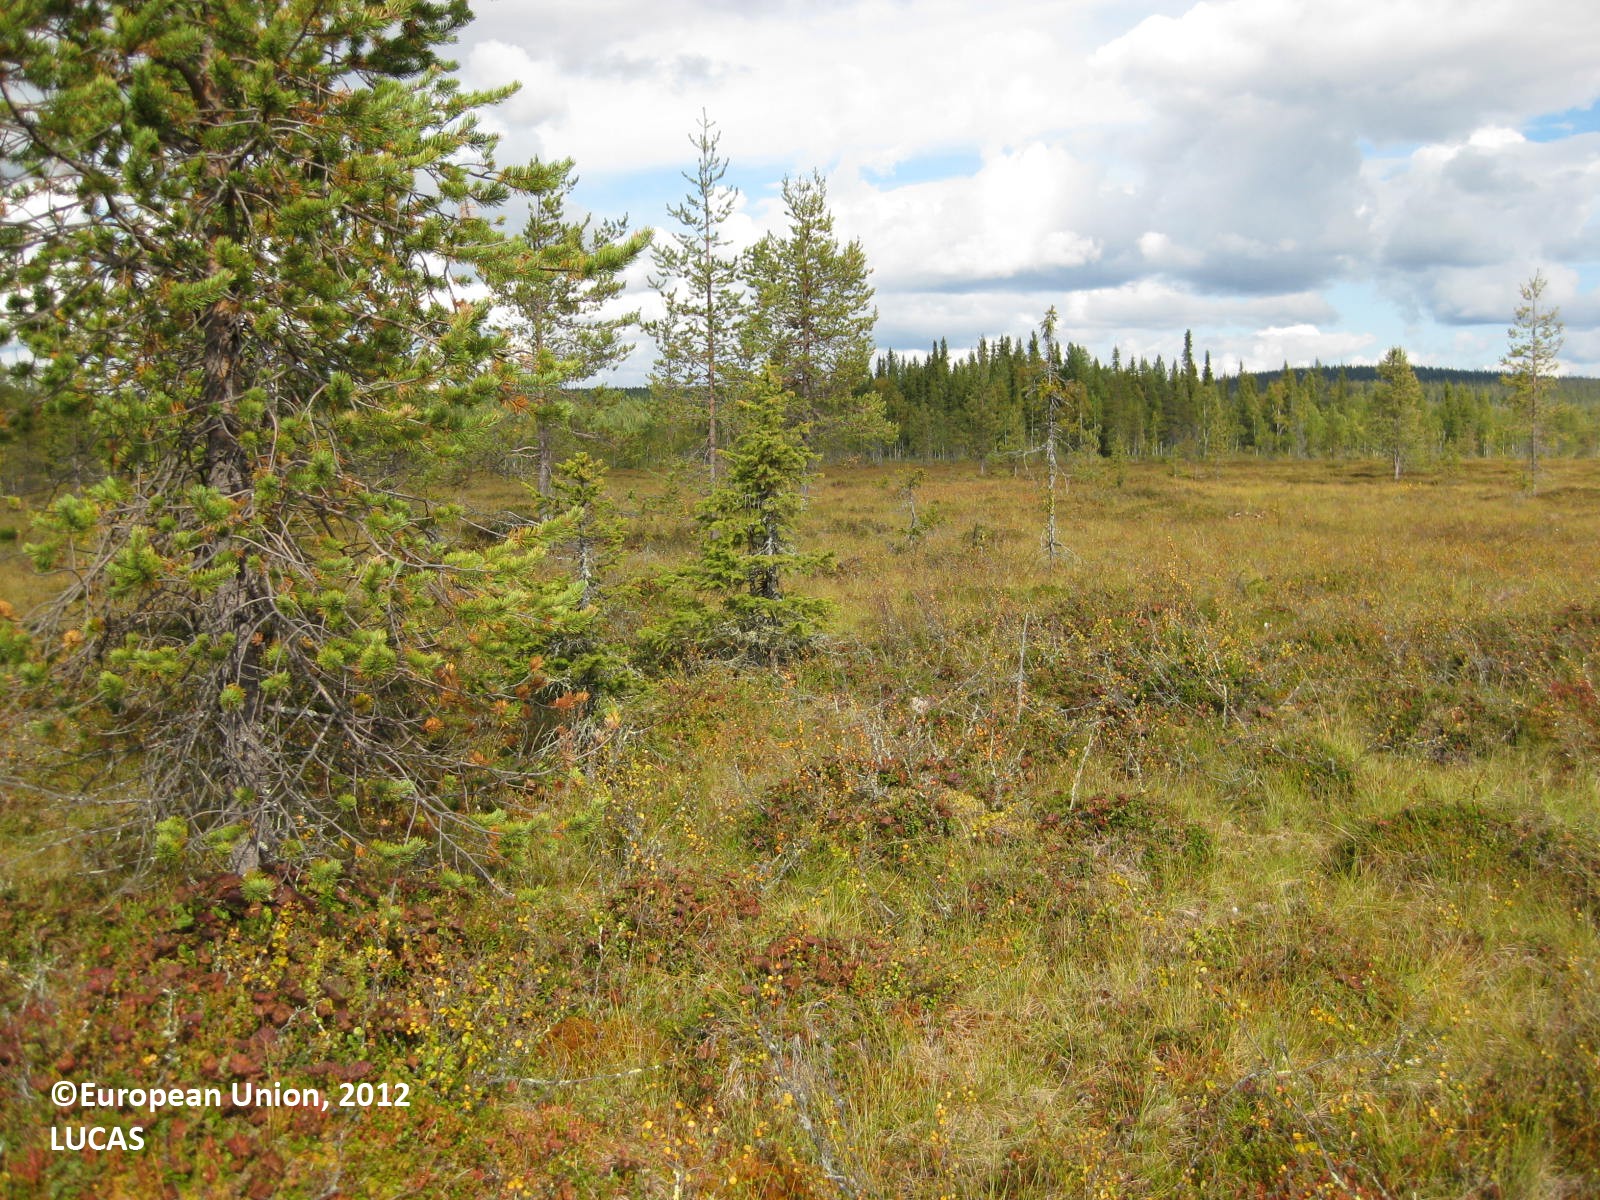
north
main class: Woodland
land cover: Other coniferous woodland
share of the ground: 10 - 25 %
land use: Semi-natural and natural areas not in use
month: August
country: FI
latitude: 66.1249
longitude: 29.8876
